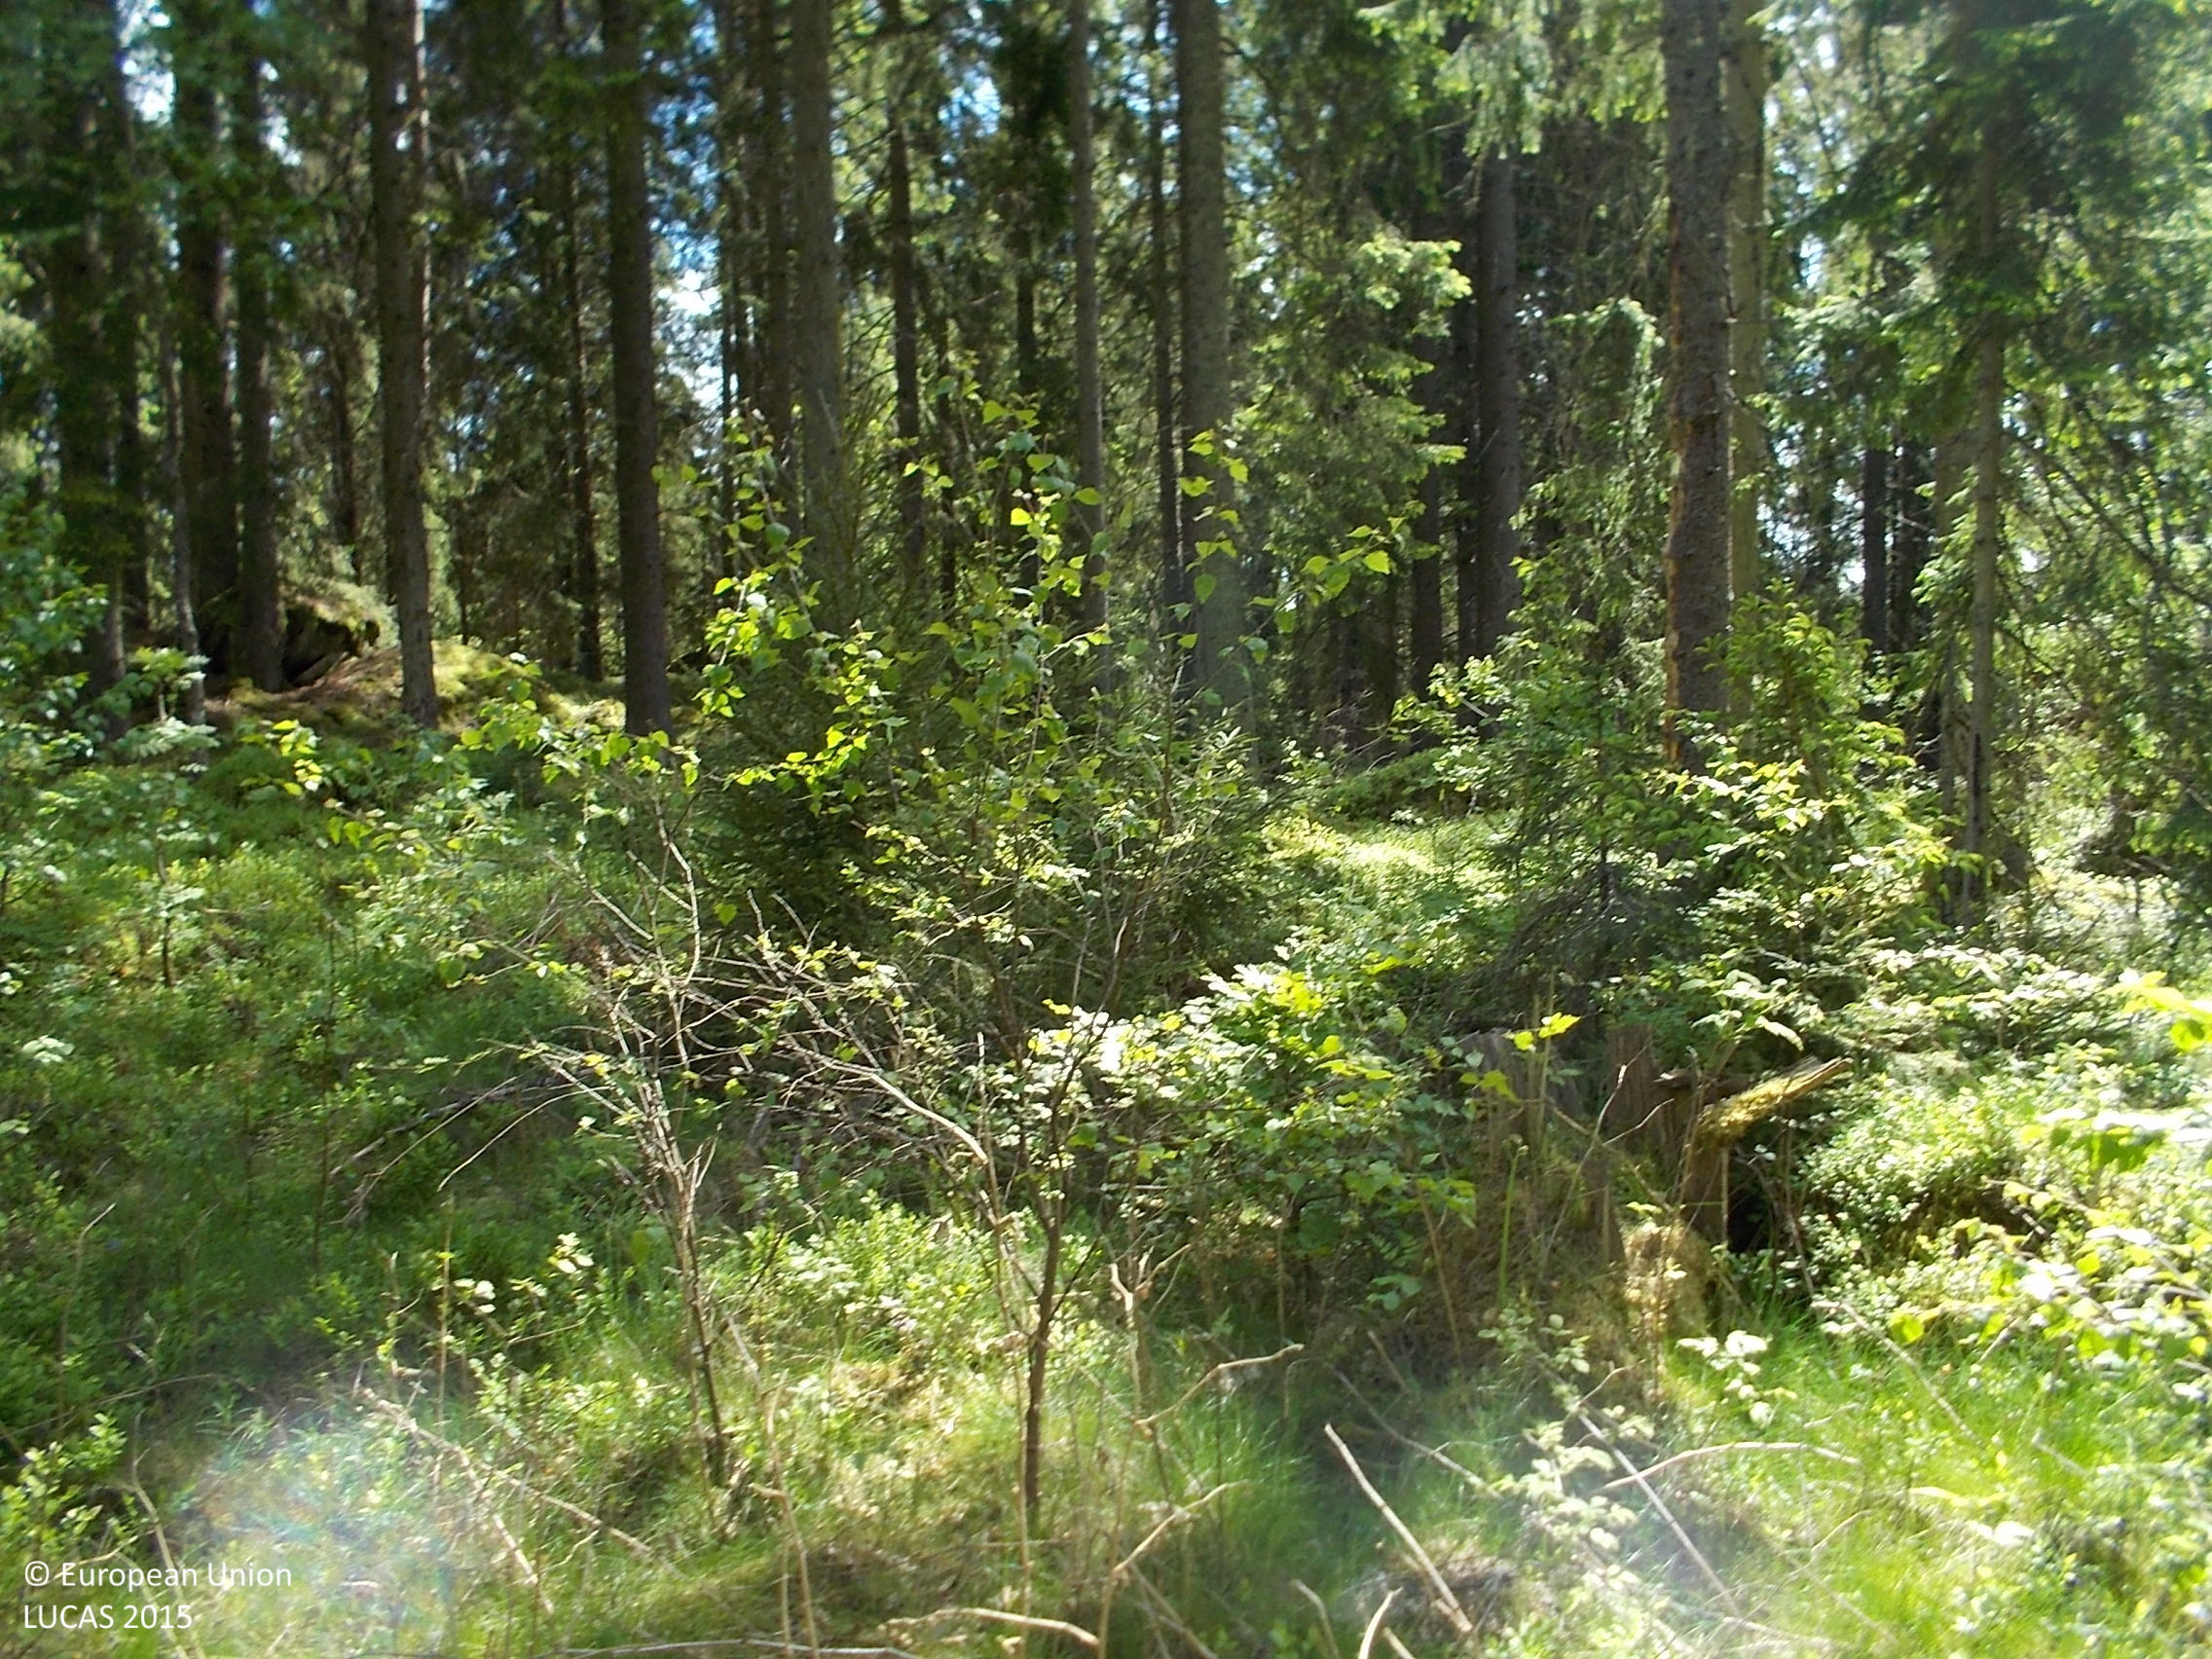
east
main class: Woodland
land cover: Spruce dominated coniferous woodland
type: boreal forest
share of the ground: 50 - 75 %
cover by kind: coniferous forest trees 70 %, shrubs 10 %, lichens and mosses 10 %, broadleaved forest trees 5 %, herbaceous plants 5 %
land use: Forestry
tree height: > 5 m
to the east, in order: Spruce dominated coniferous woodland; Spruce dominated mixed woodland; Broadleaved woodland
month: June
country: SE
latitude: 57.6759
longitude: 13.2652
